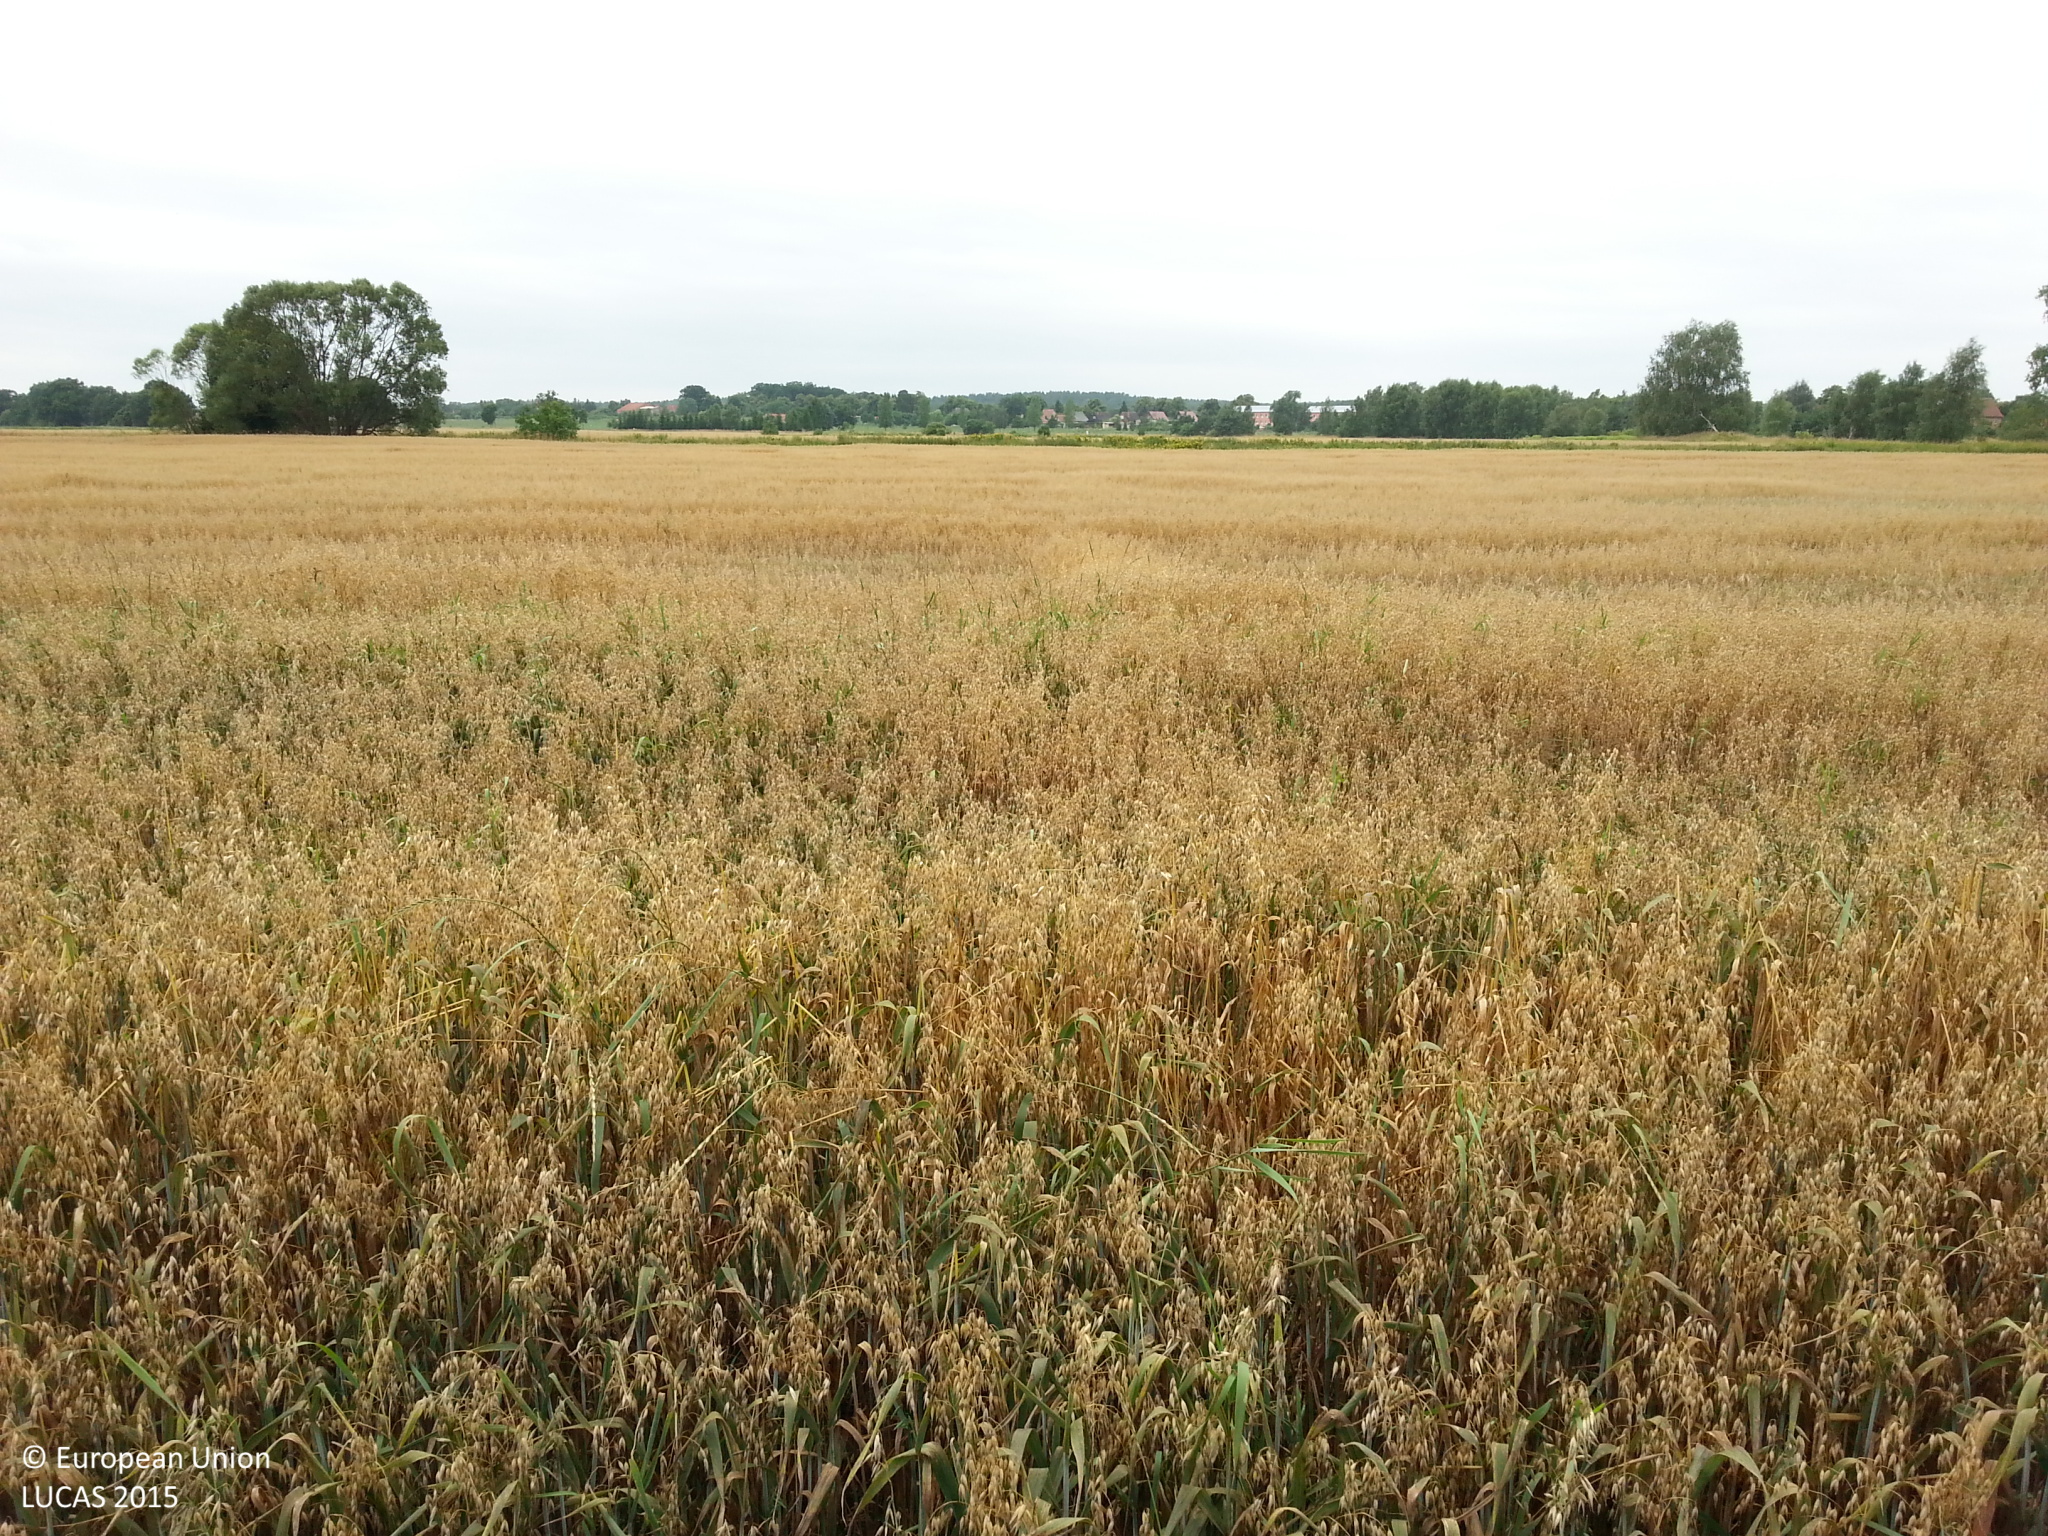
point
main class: Cropland
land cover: Barley
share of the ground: > 75 %
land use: Agriculture (excluding fallow land and kitchen gardens)
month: July
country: DE
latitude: 53.0736
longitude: 12.3428
